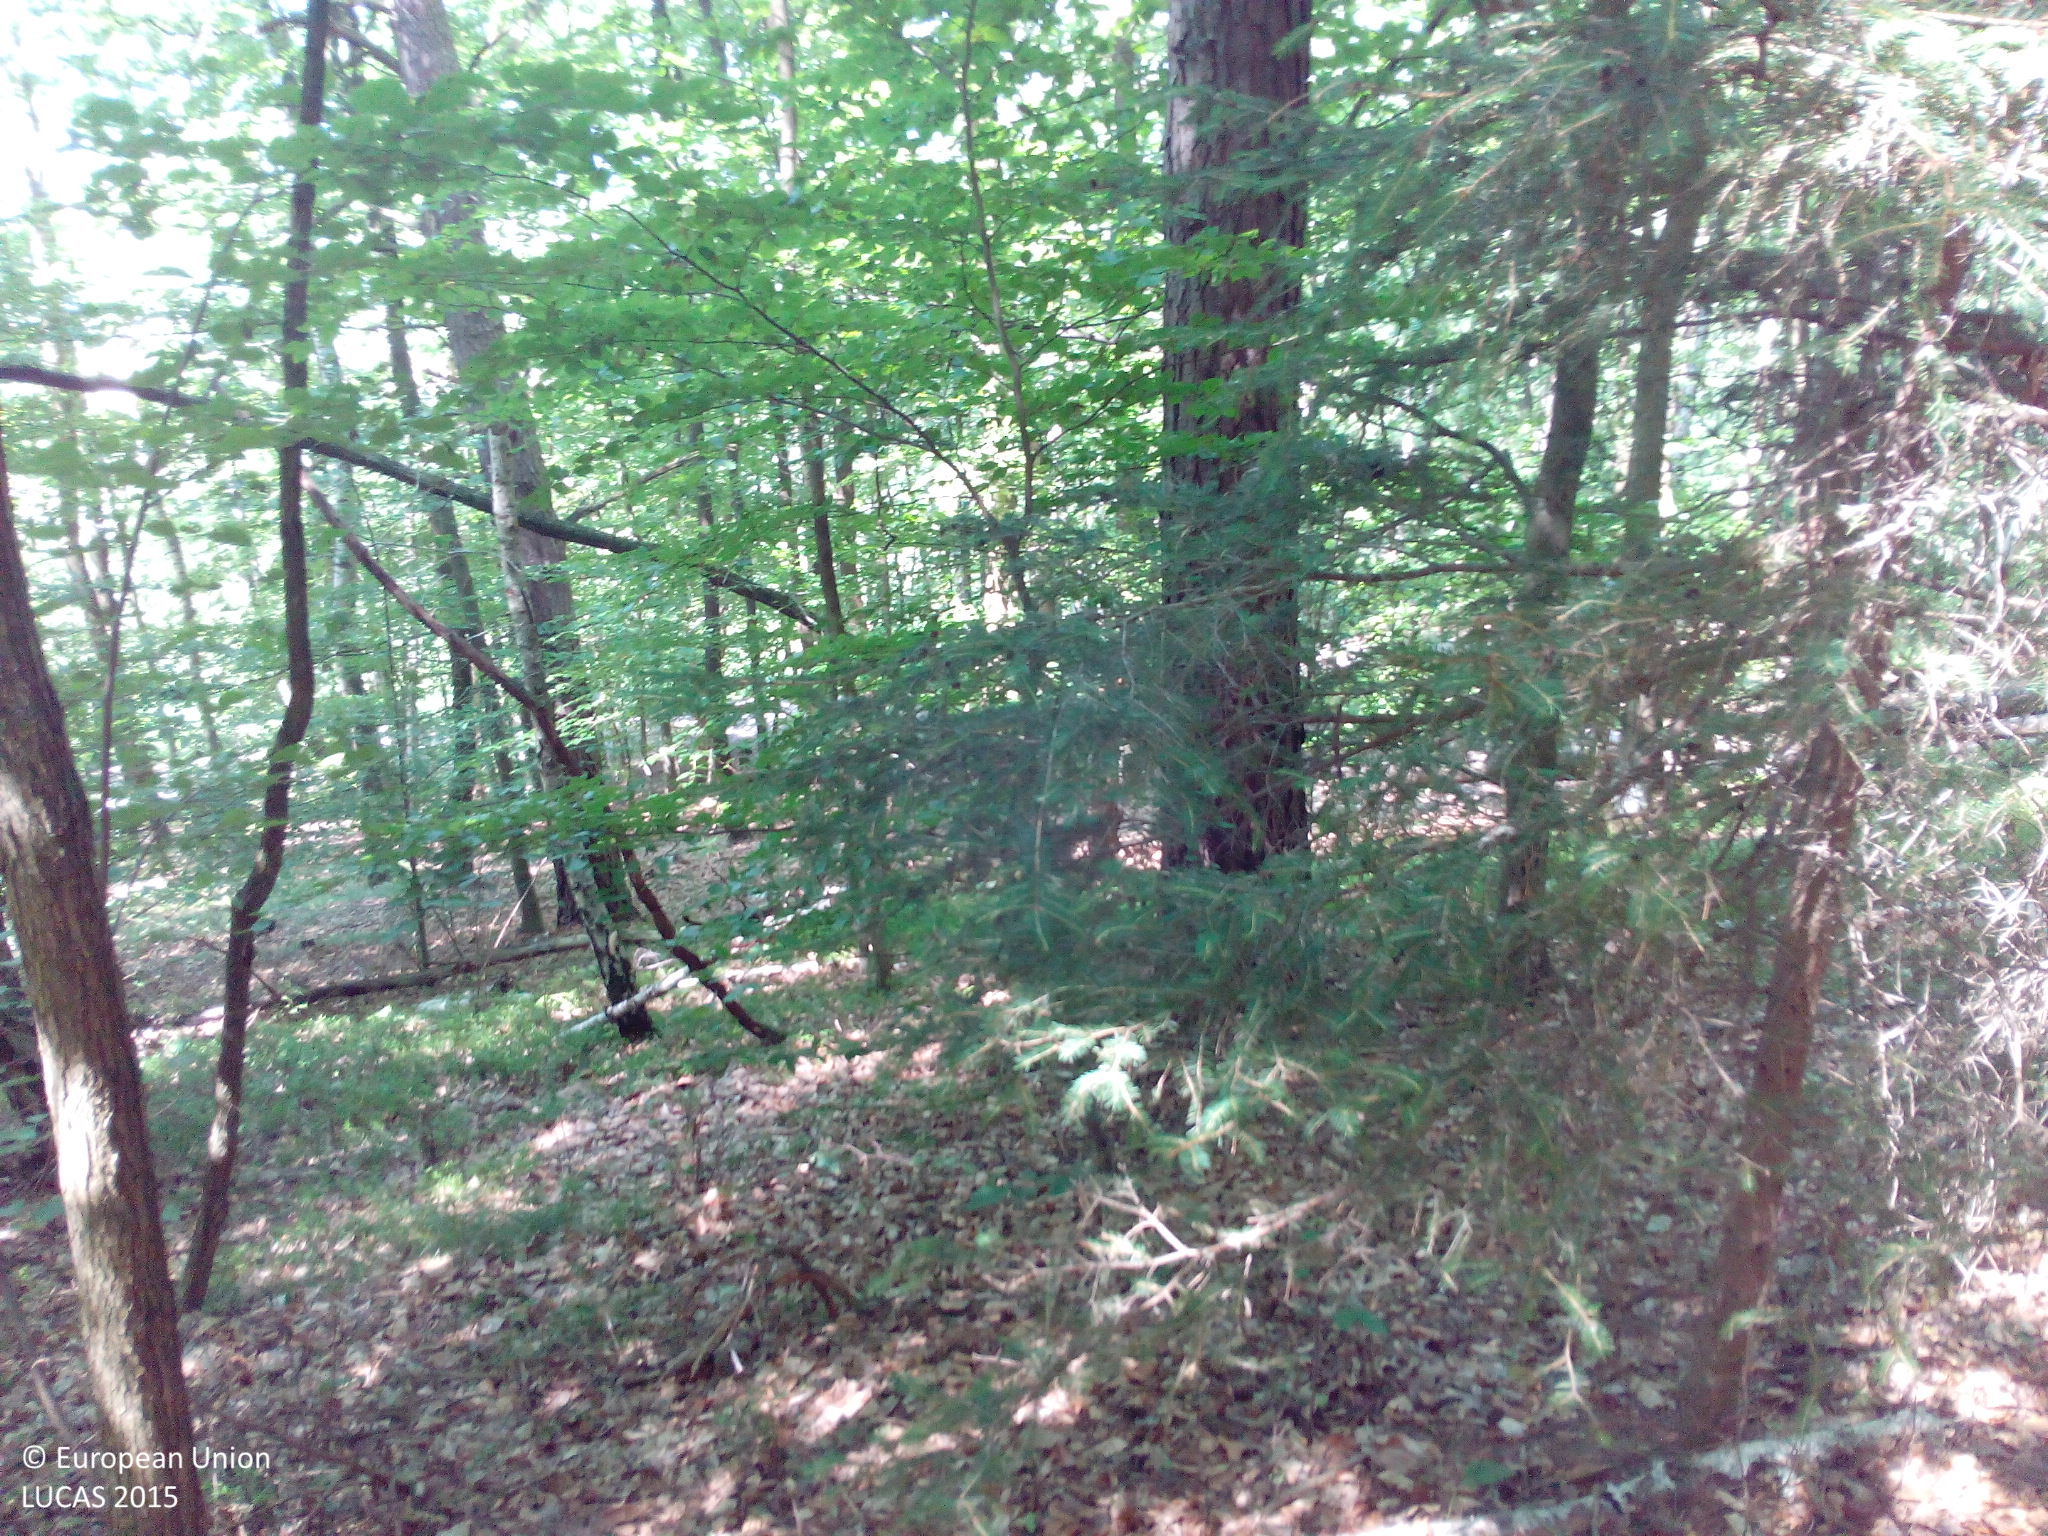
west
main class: Woodland
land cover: Pine dominated mixed woodland
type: hemiboreal forest and nemoral coniferous forest and mixed broadleaved-coniferous forest
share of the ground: > 75 %
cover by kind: broadleaved forest trees 60 %, coniferous forest trees 30 %, herbaceous plants 5 %, unconsolidated bare surface 5 %
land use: Forestry
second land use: Amenities, museums, leisure
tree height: > 5 m
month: July
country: DE
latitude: 49.8195
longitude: 11.0699
